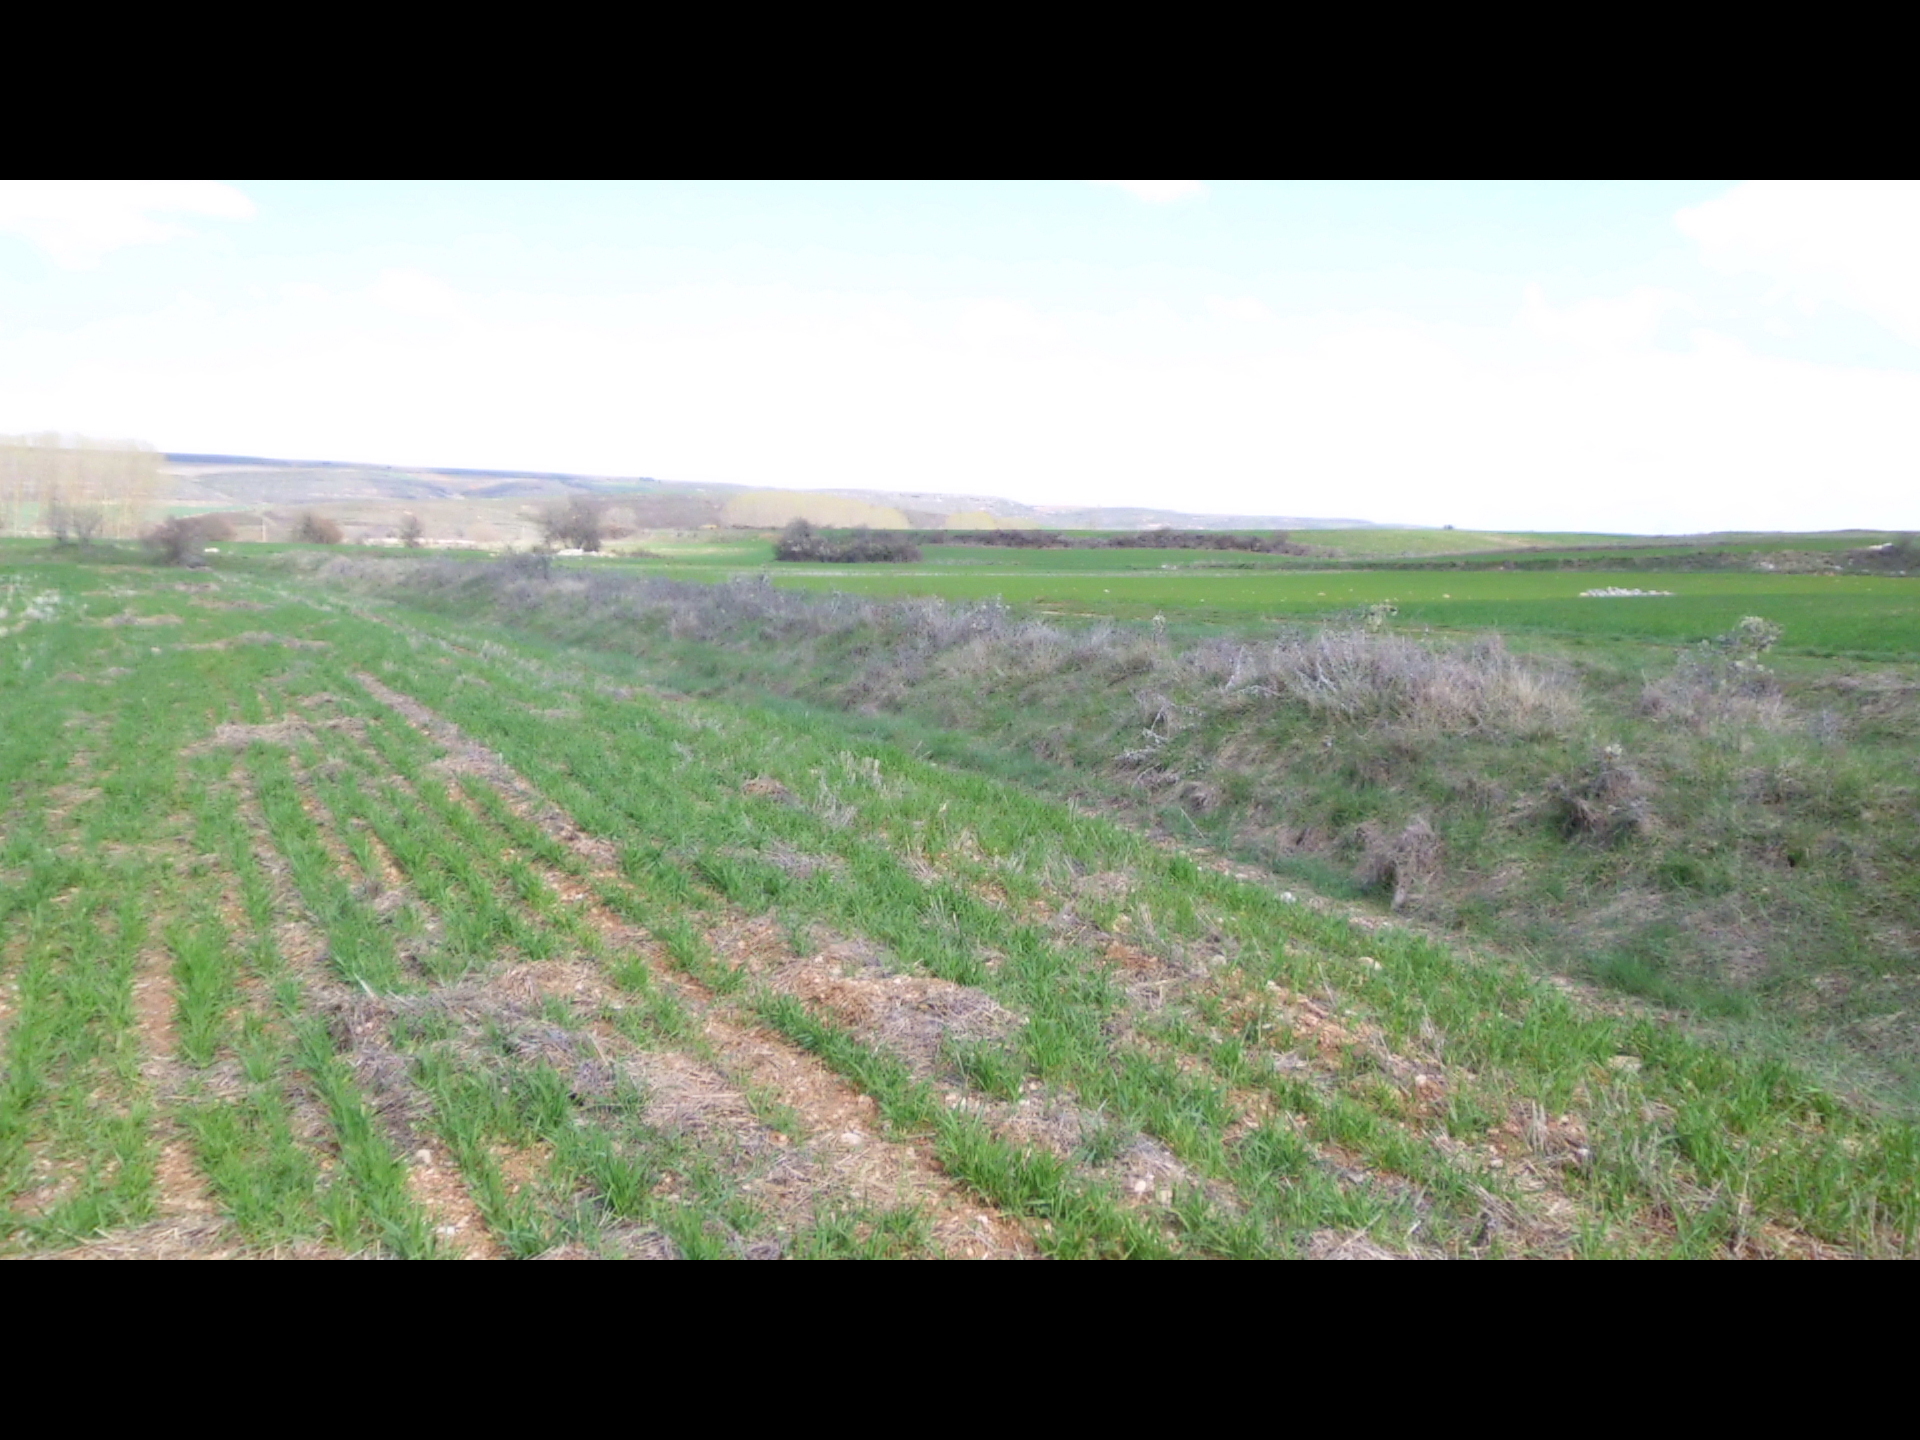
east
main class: Cropland
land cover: Barley
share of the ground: > 75 %
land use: Agriculture (excluding fallow land and kitchen gardens)
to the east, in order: Barley; Grass margins; Ditches and canals; Grass margins; Tracks; Grass margins; Barley; Grass margins; Common wheat; Grass margins; Barley; Grass margins; Barley; Grass margins; Barley
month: April
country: ES
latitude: 42.6150
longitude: -3.8290
